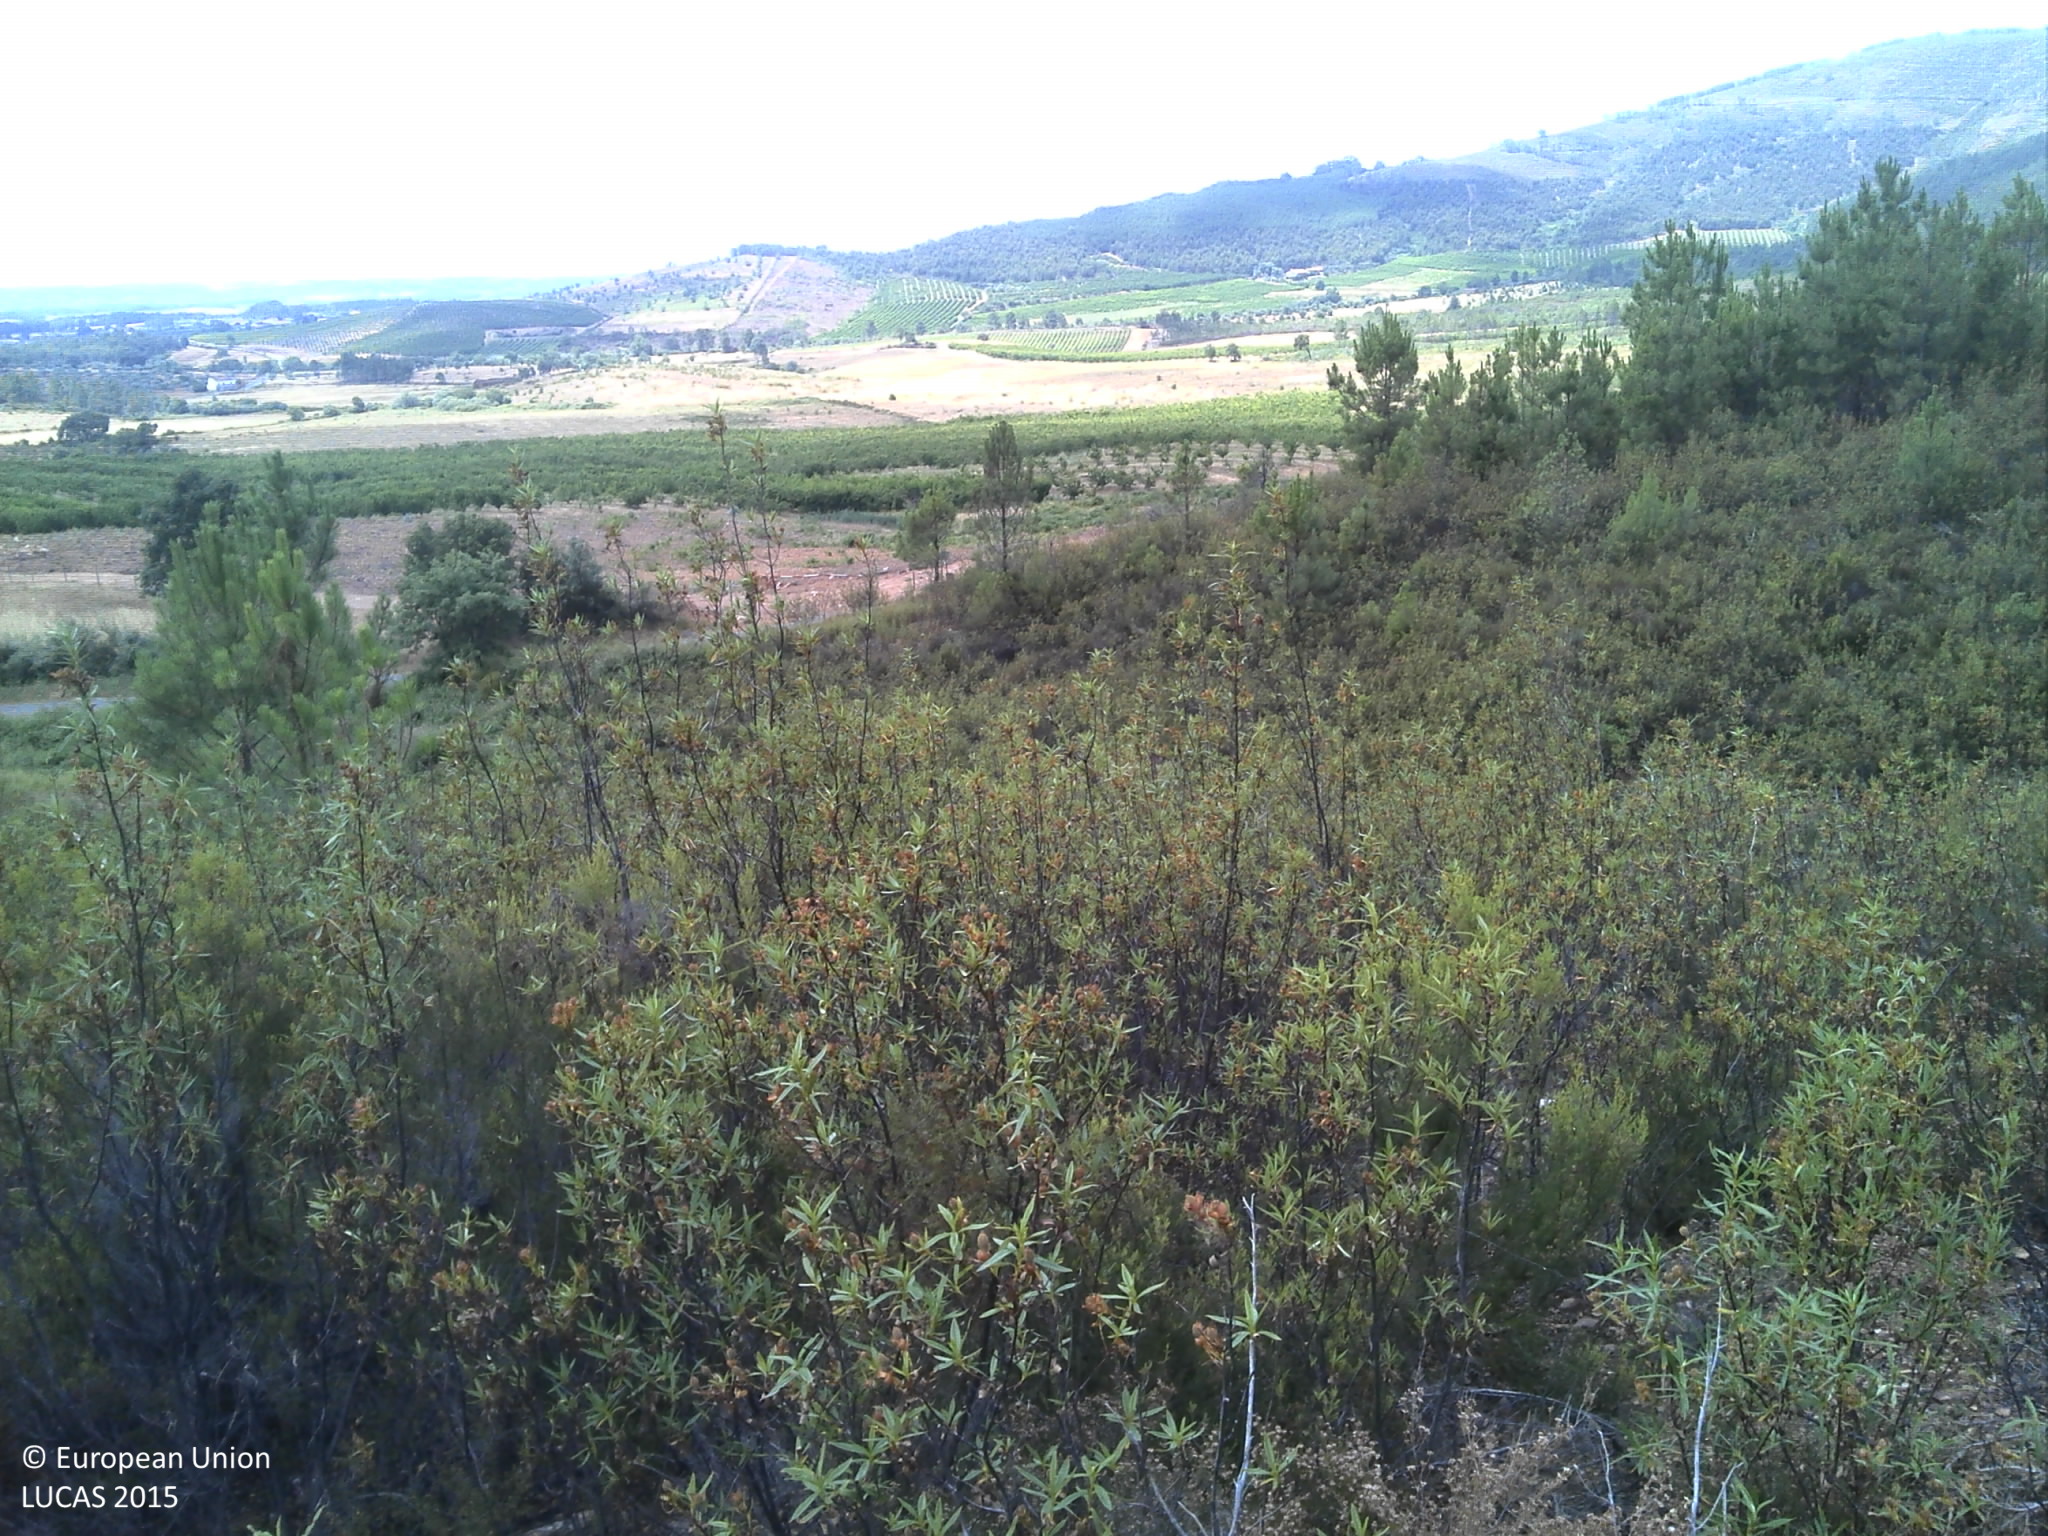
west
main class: Woodland
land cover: Pine dominated coniferous woodland
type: coniferous forest of the mediterranean region
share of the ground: 10 - 25 %
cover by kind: shrubs 55 %, coniferous forest trees 25 %, unconsolidated bare surface 20 %
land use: Forestry
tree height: > 5 m
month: June
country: PT
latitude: 40.1266
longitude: -7.3633
